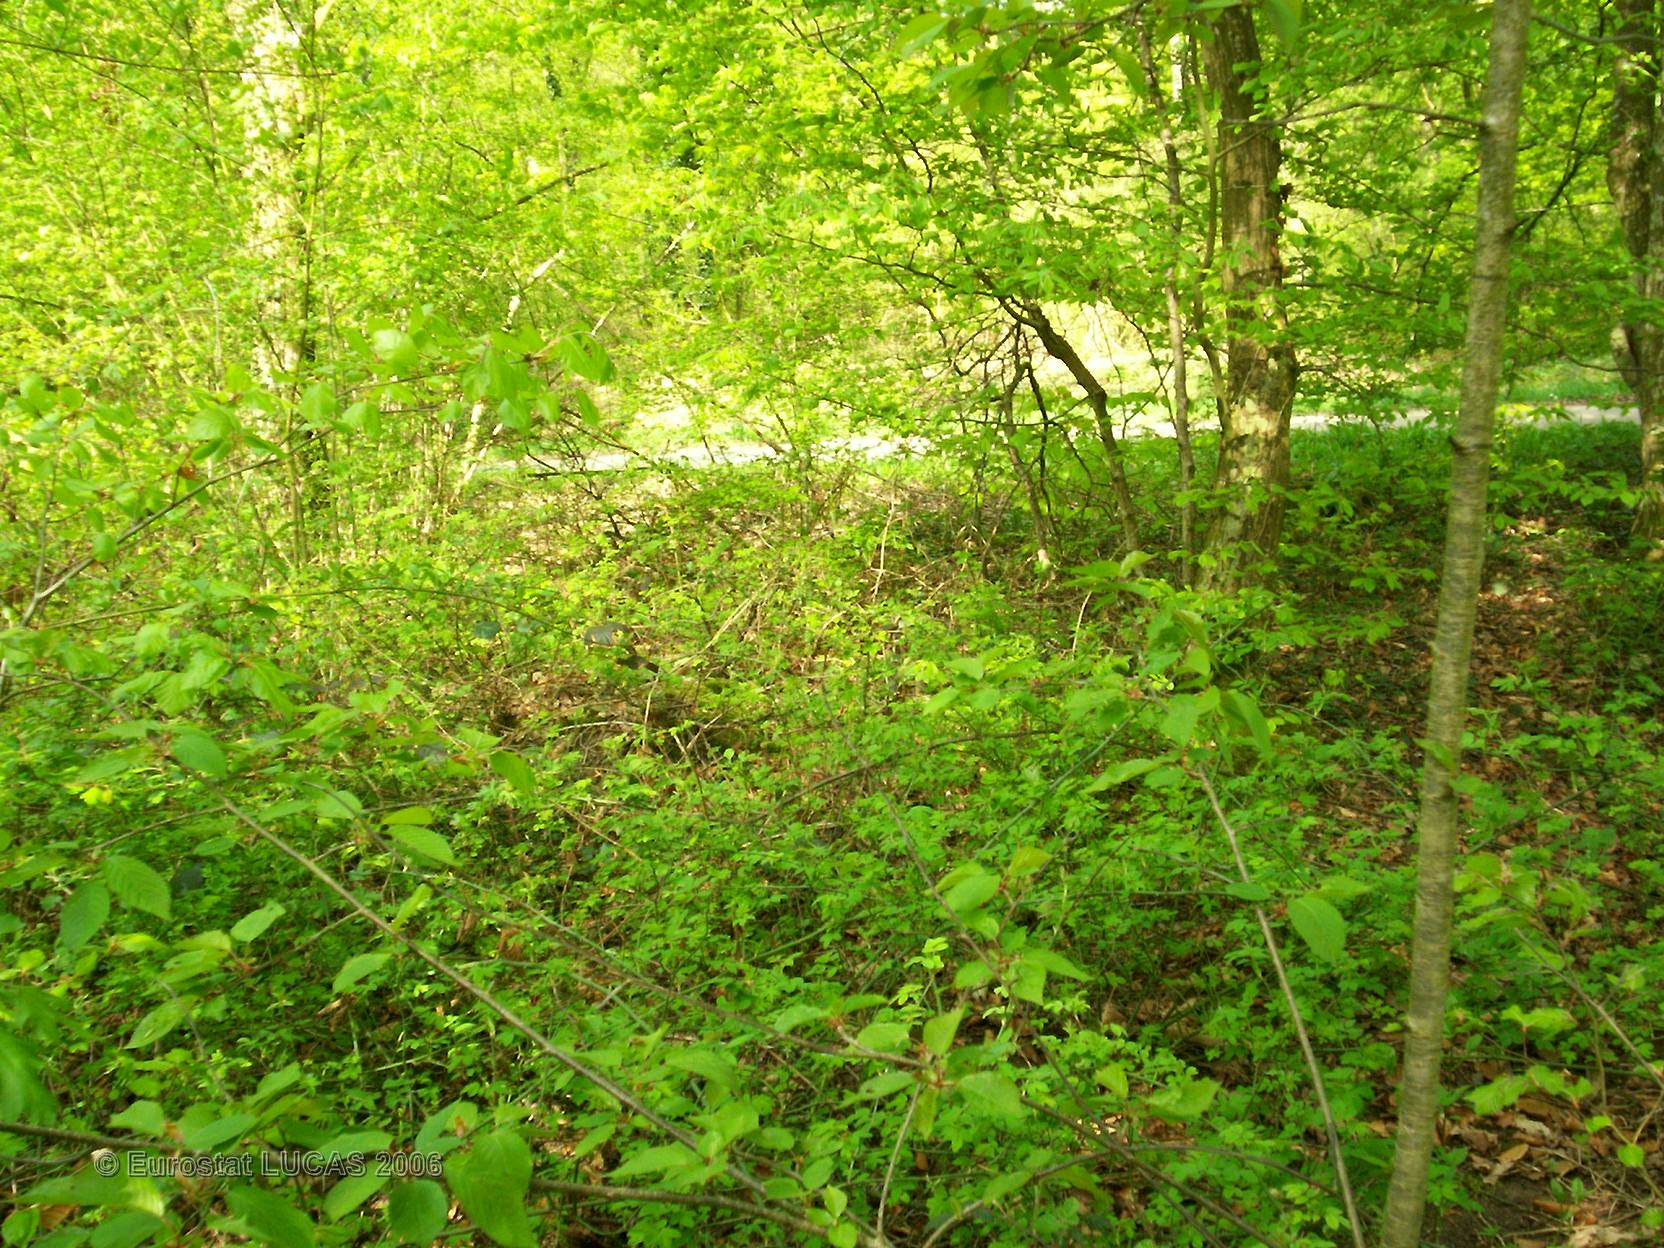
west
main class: Woodland
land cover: Broadleaved forest
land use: Forestry
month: April
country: FR
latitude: 49.0230
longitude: 6.7866
